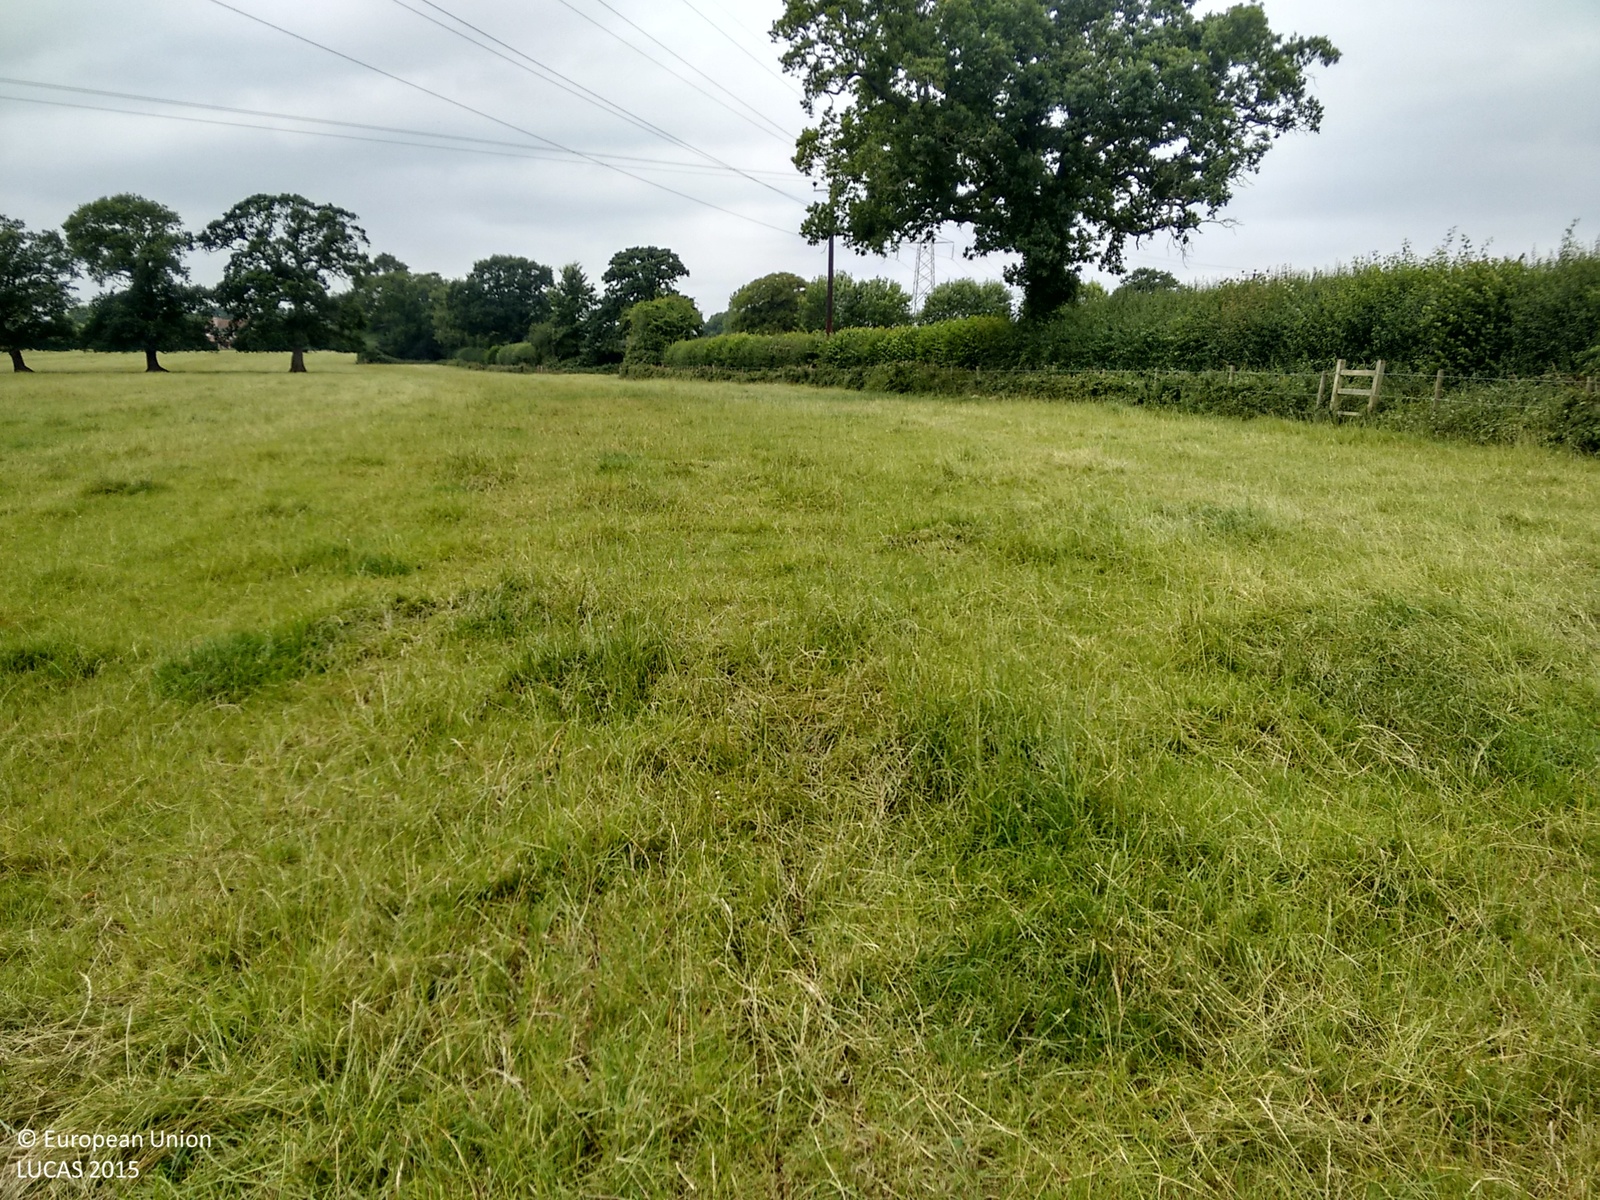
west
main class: Grassland
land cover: Grassland without tree/shrub cover
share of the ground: > 75 %
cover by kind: herbaceous plants 100 %
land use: Agriculture (excluding fallow land and kitchen gardens)
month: July
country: GB
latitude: 51.3553
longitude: -2.7797
